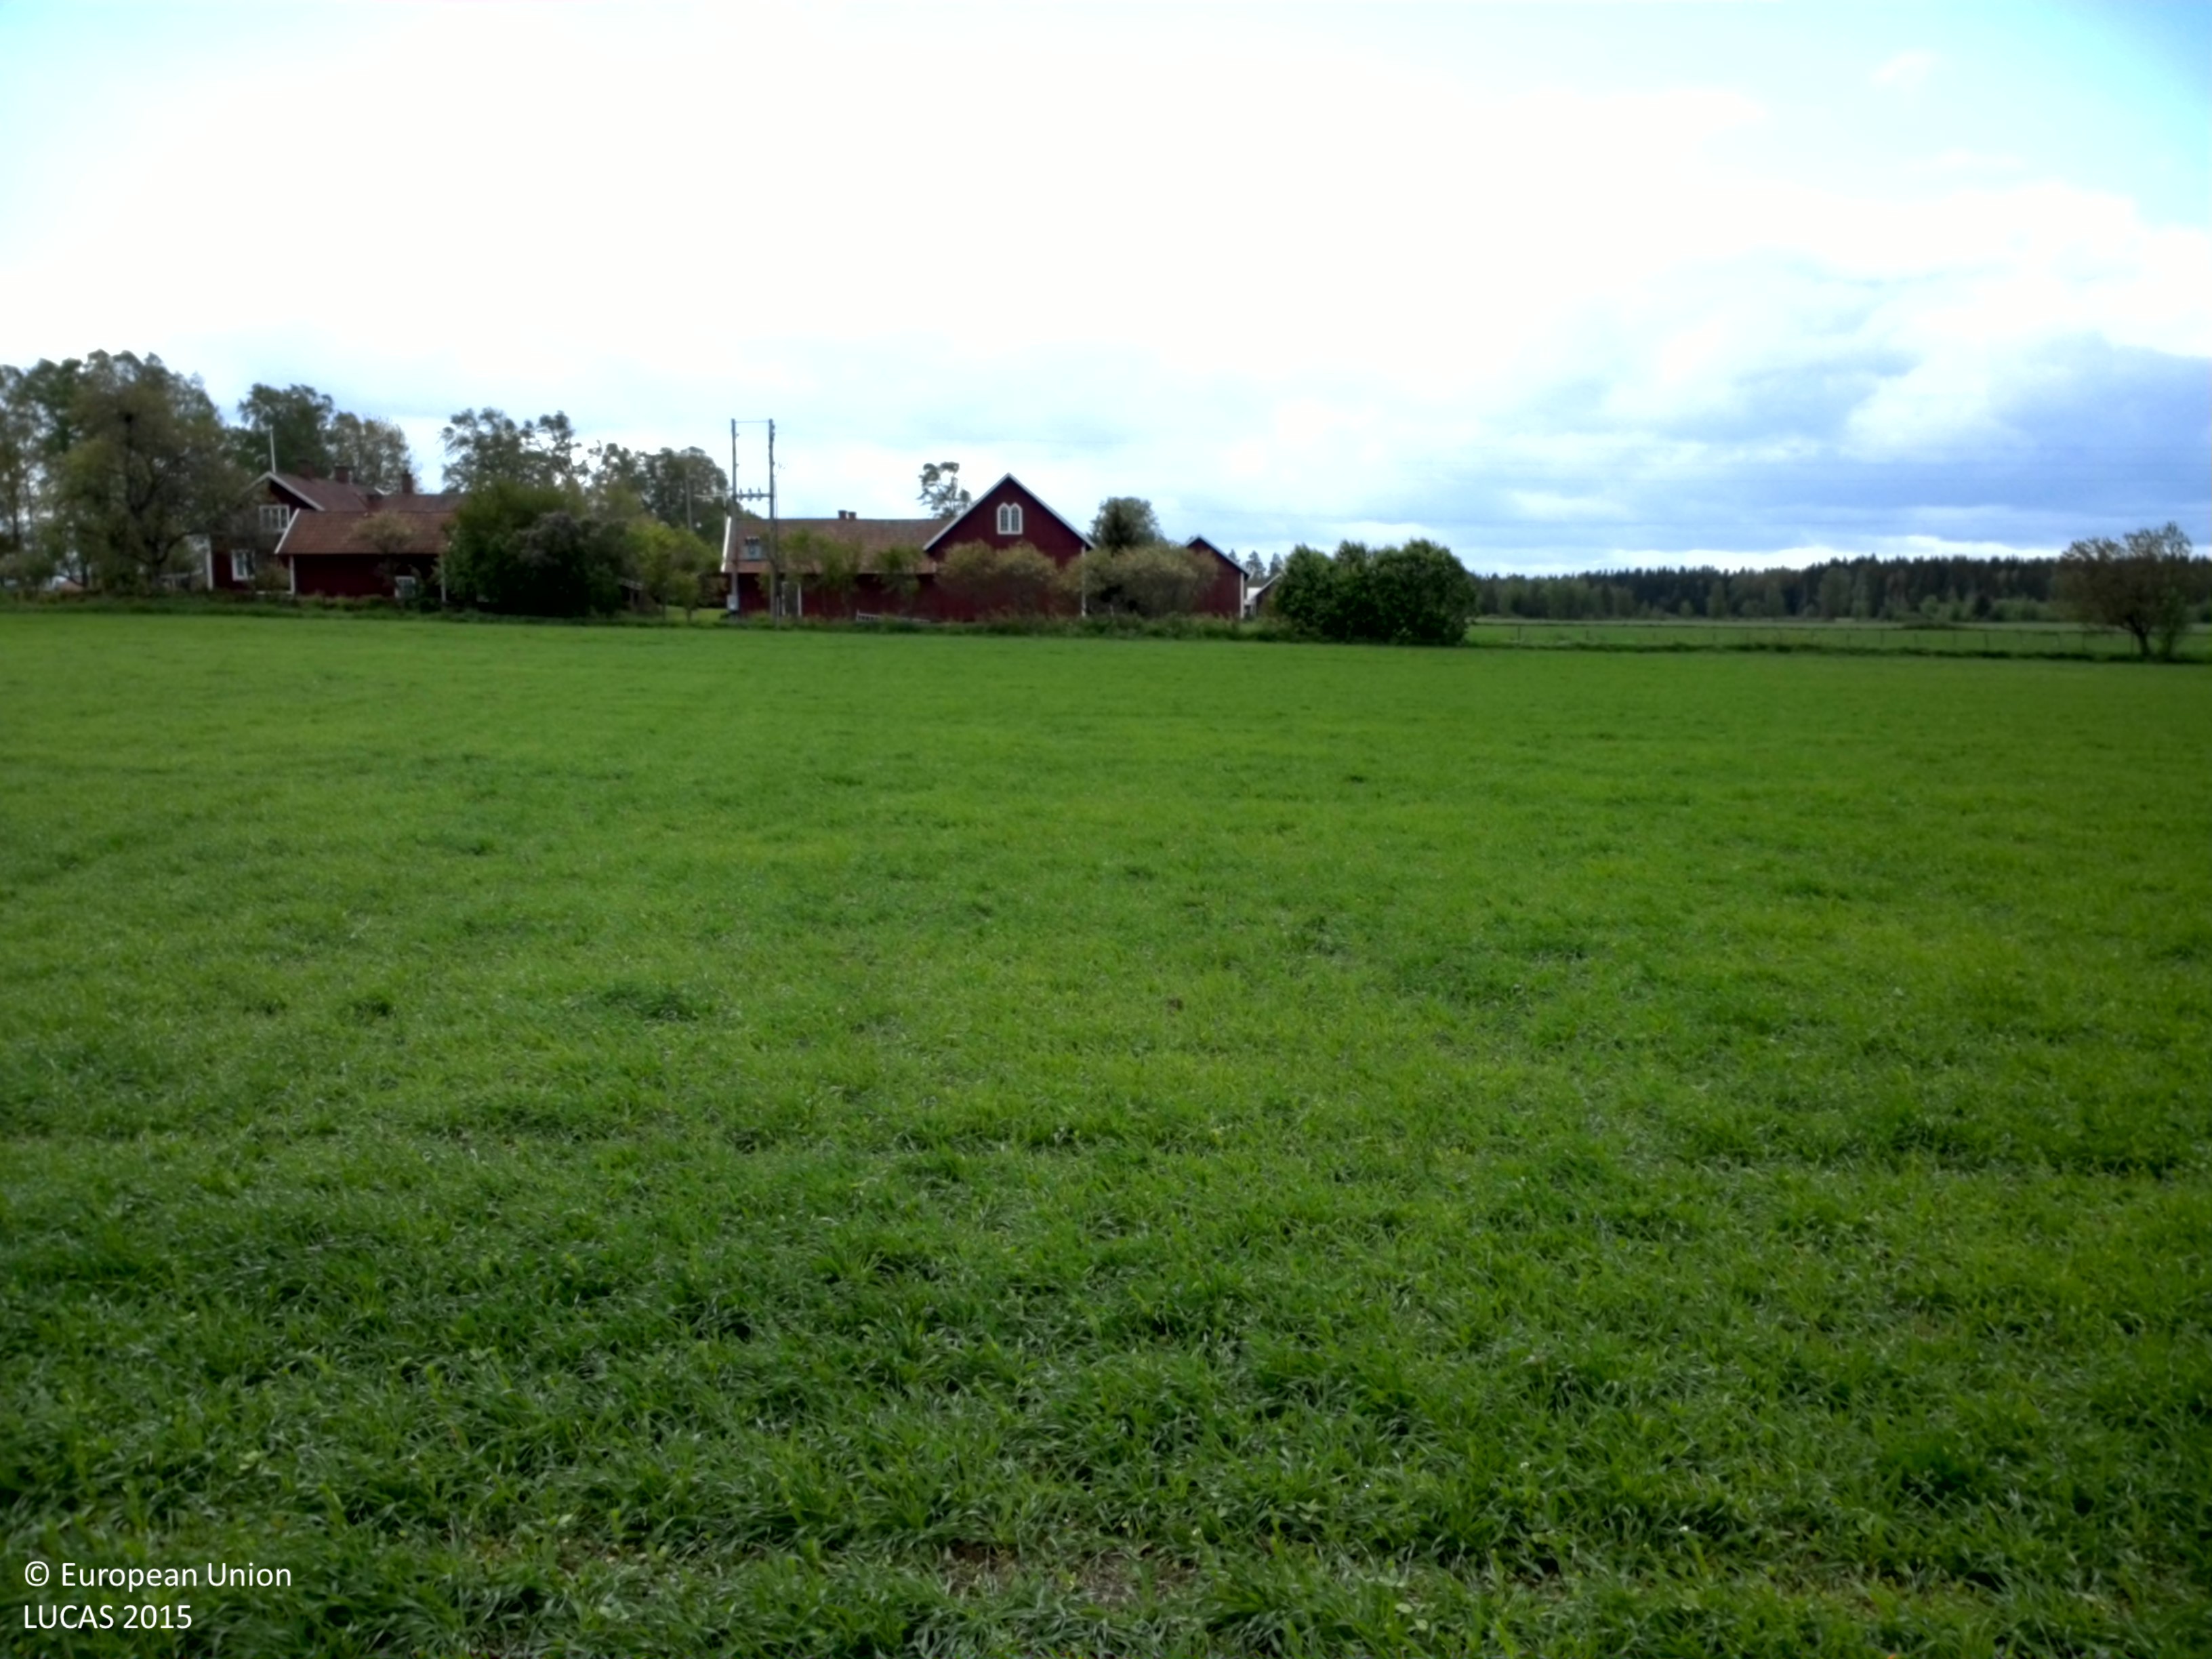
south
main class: Cropland
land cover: Barley
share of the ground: > 75 %
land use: Agriculture (excluding fallow land and kitchen gardens)
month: June
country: SE
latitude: 58.3230
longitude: 13.9720
